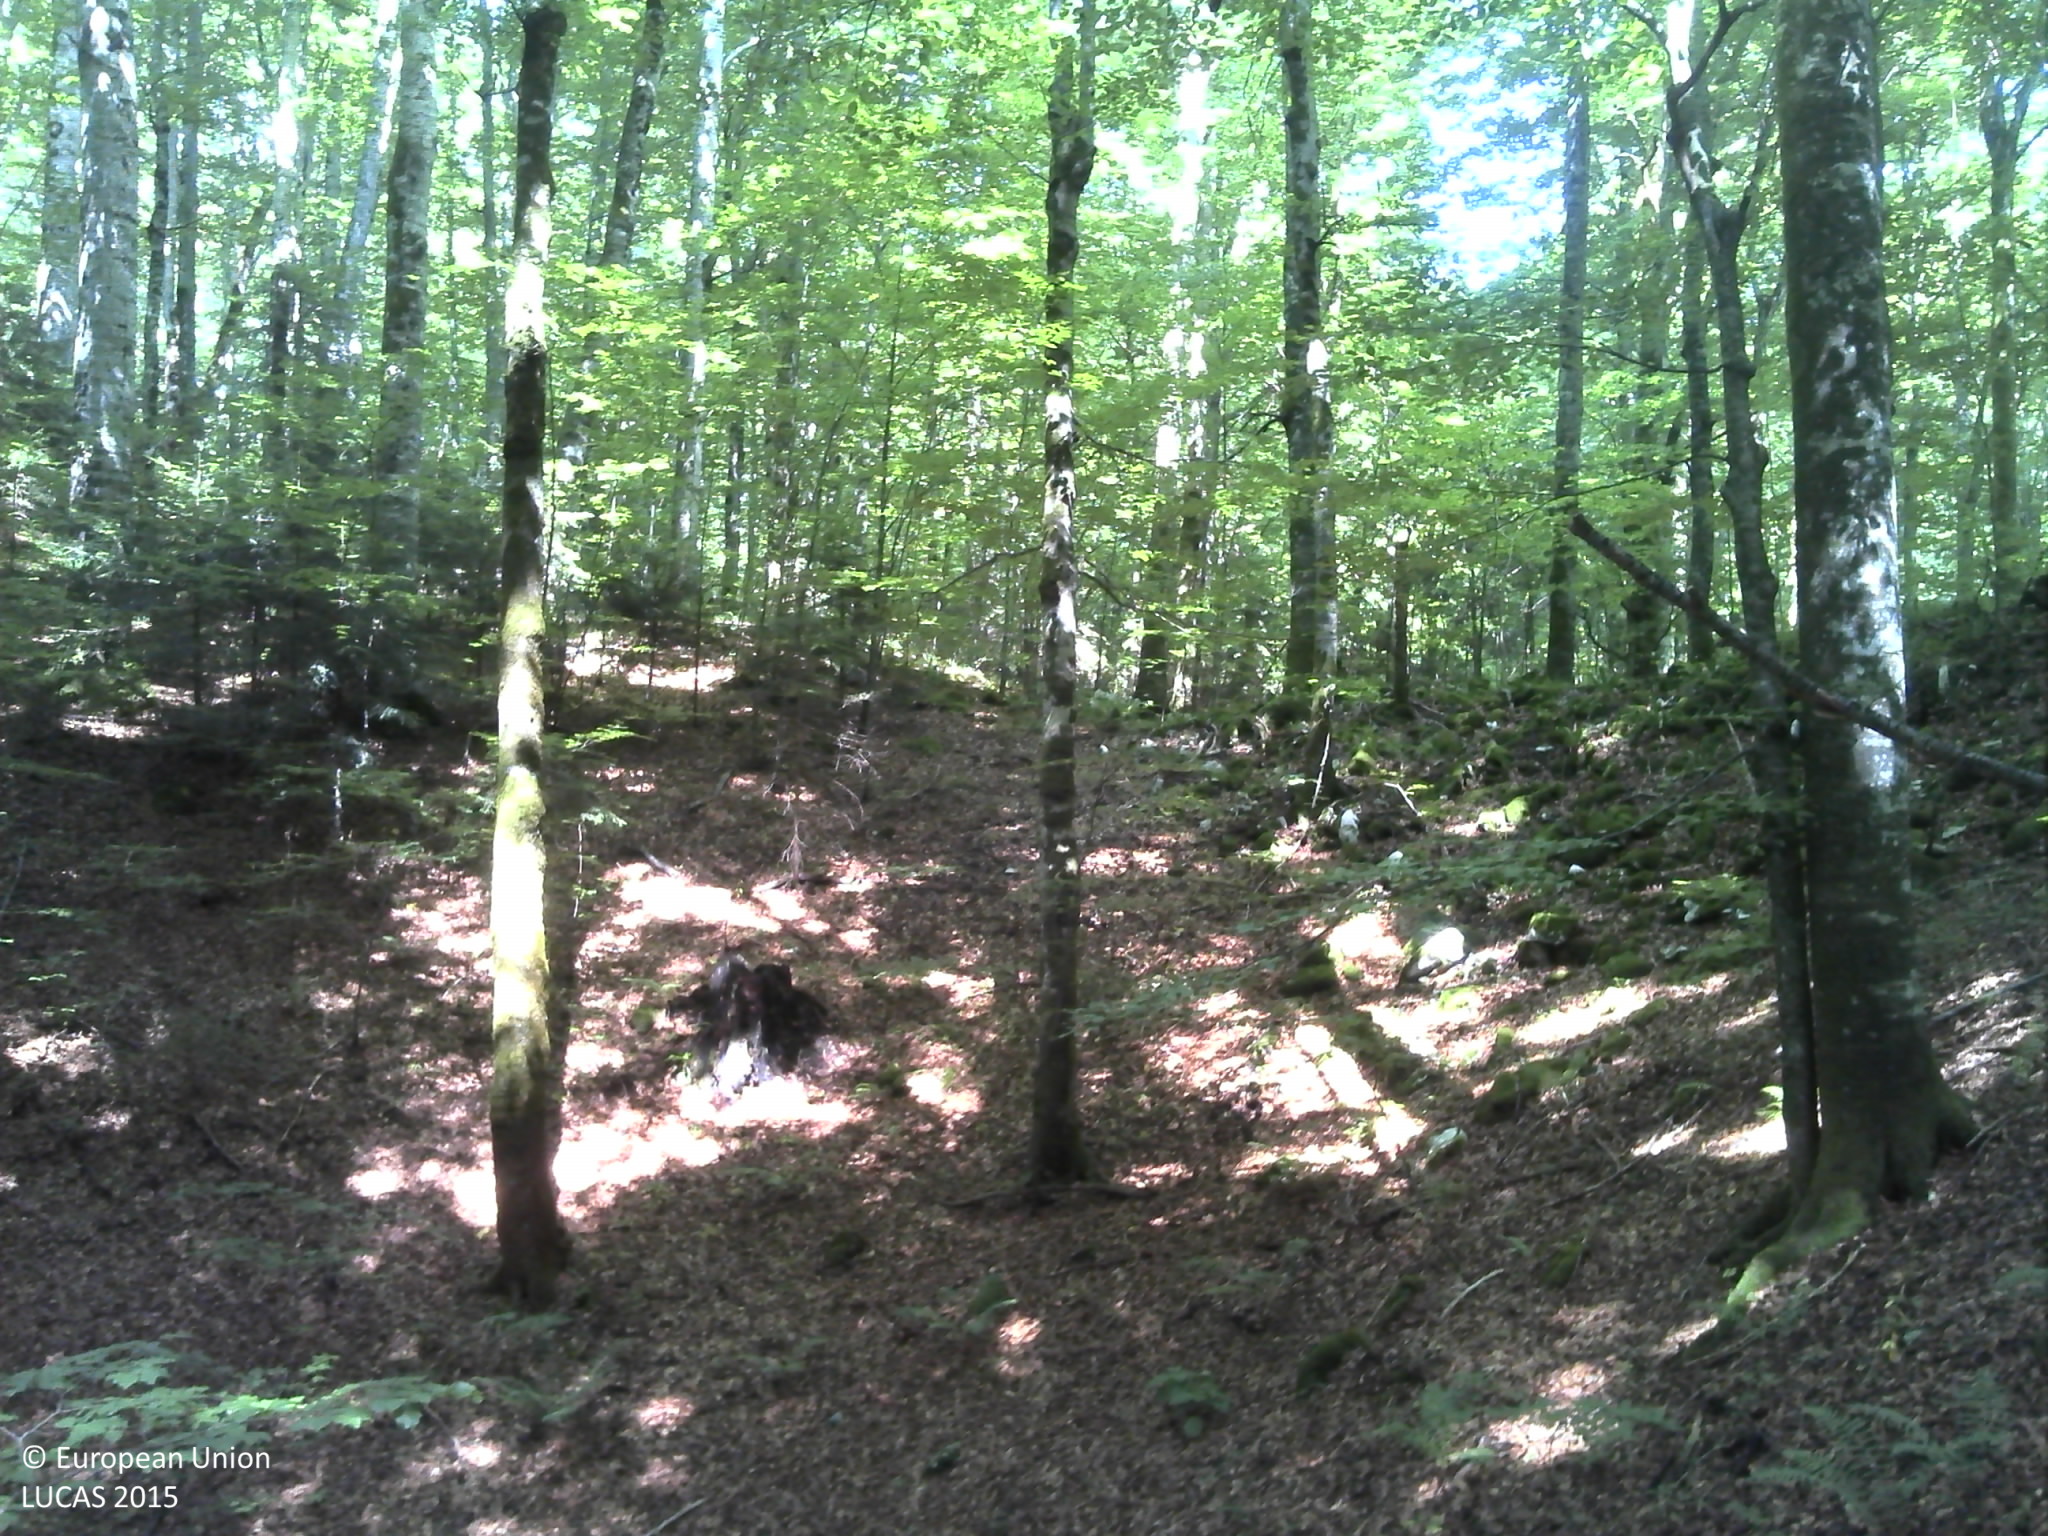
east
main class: Woodland
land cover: Broadleaved woodland
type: beech forest
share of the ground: > 75 %
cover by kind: broadleaved forest trees 95 %, consolidated bare surface 5 %
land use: Forestry
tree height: > 5 m
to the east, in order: Broadleaved woodland
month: June
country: HR
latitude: 44.8845
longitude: 15.6285
